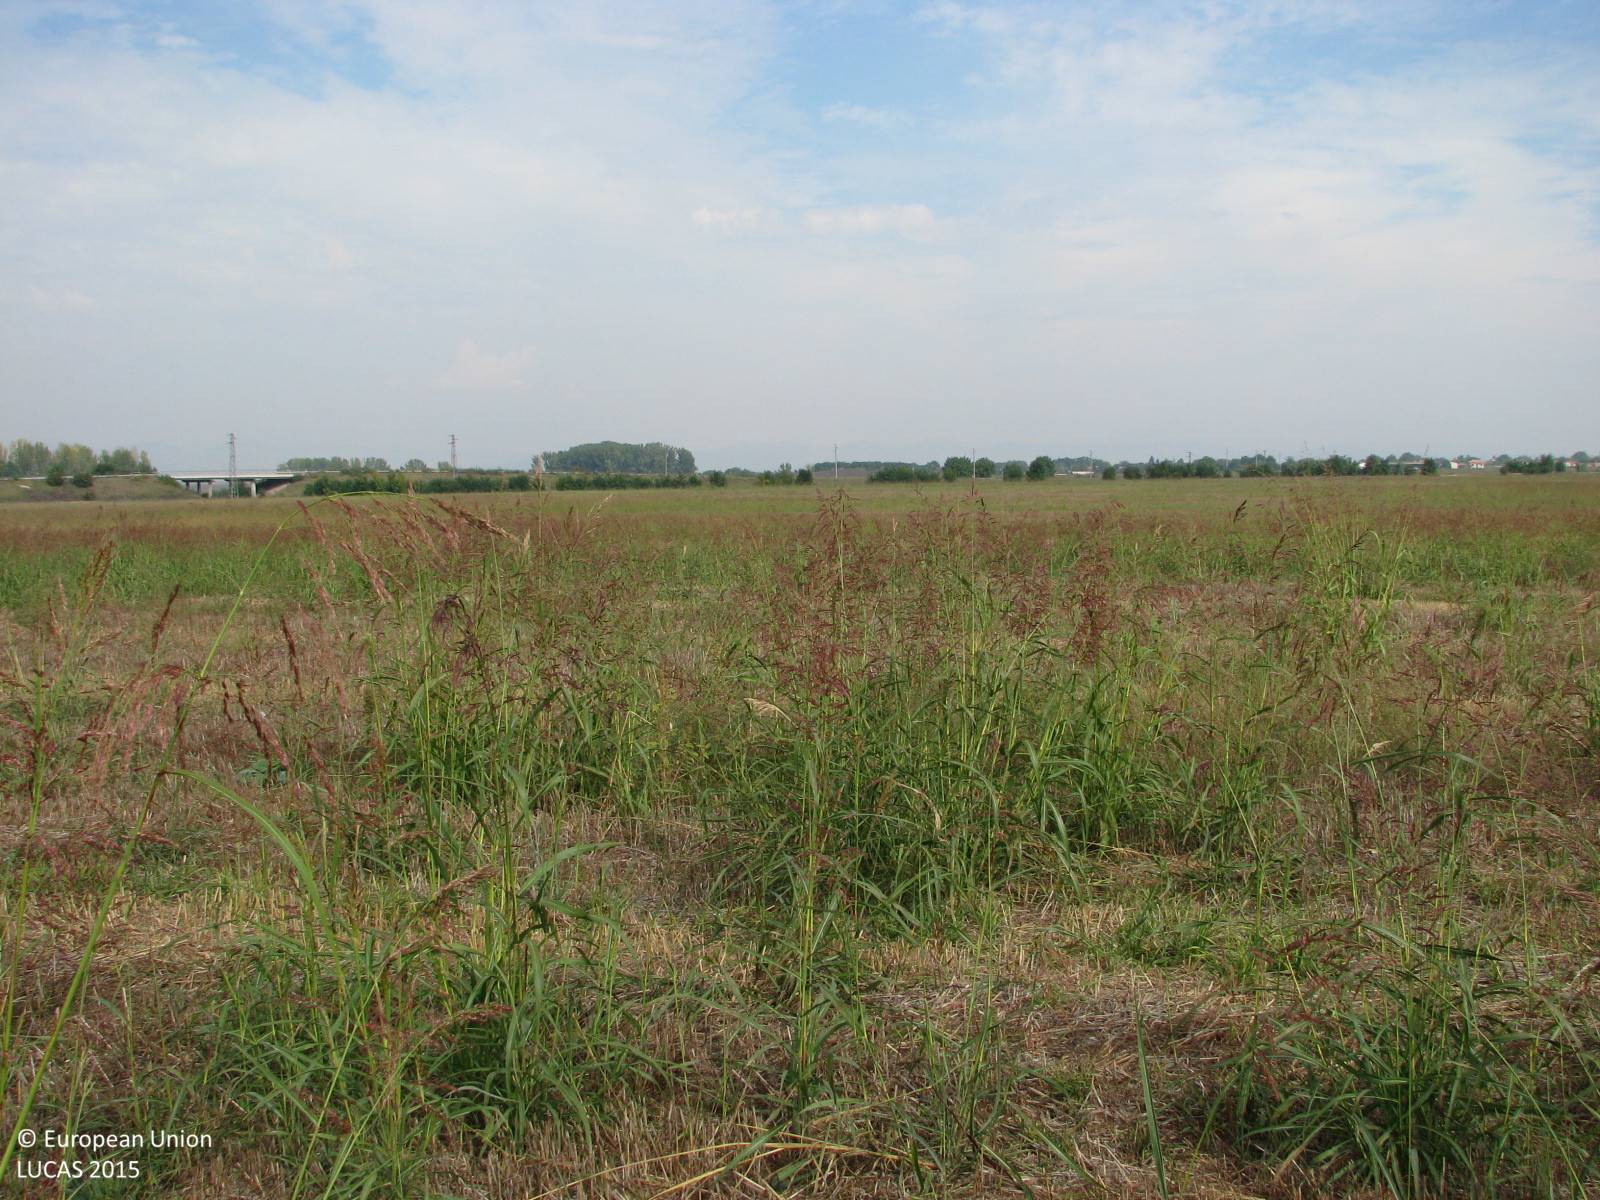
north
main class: Cropland
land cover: Oats
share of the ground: 50 - 75 %
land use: Agriculture (excluding fallow land and kitchen gardens)
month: October
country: BG
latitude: 42.4178
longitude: 26.0121
